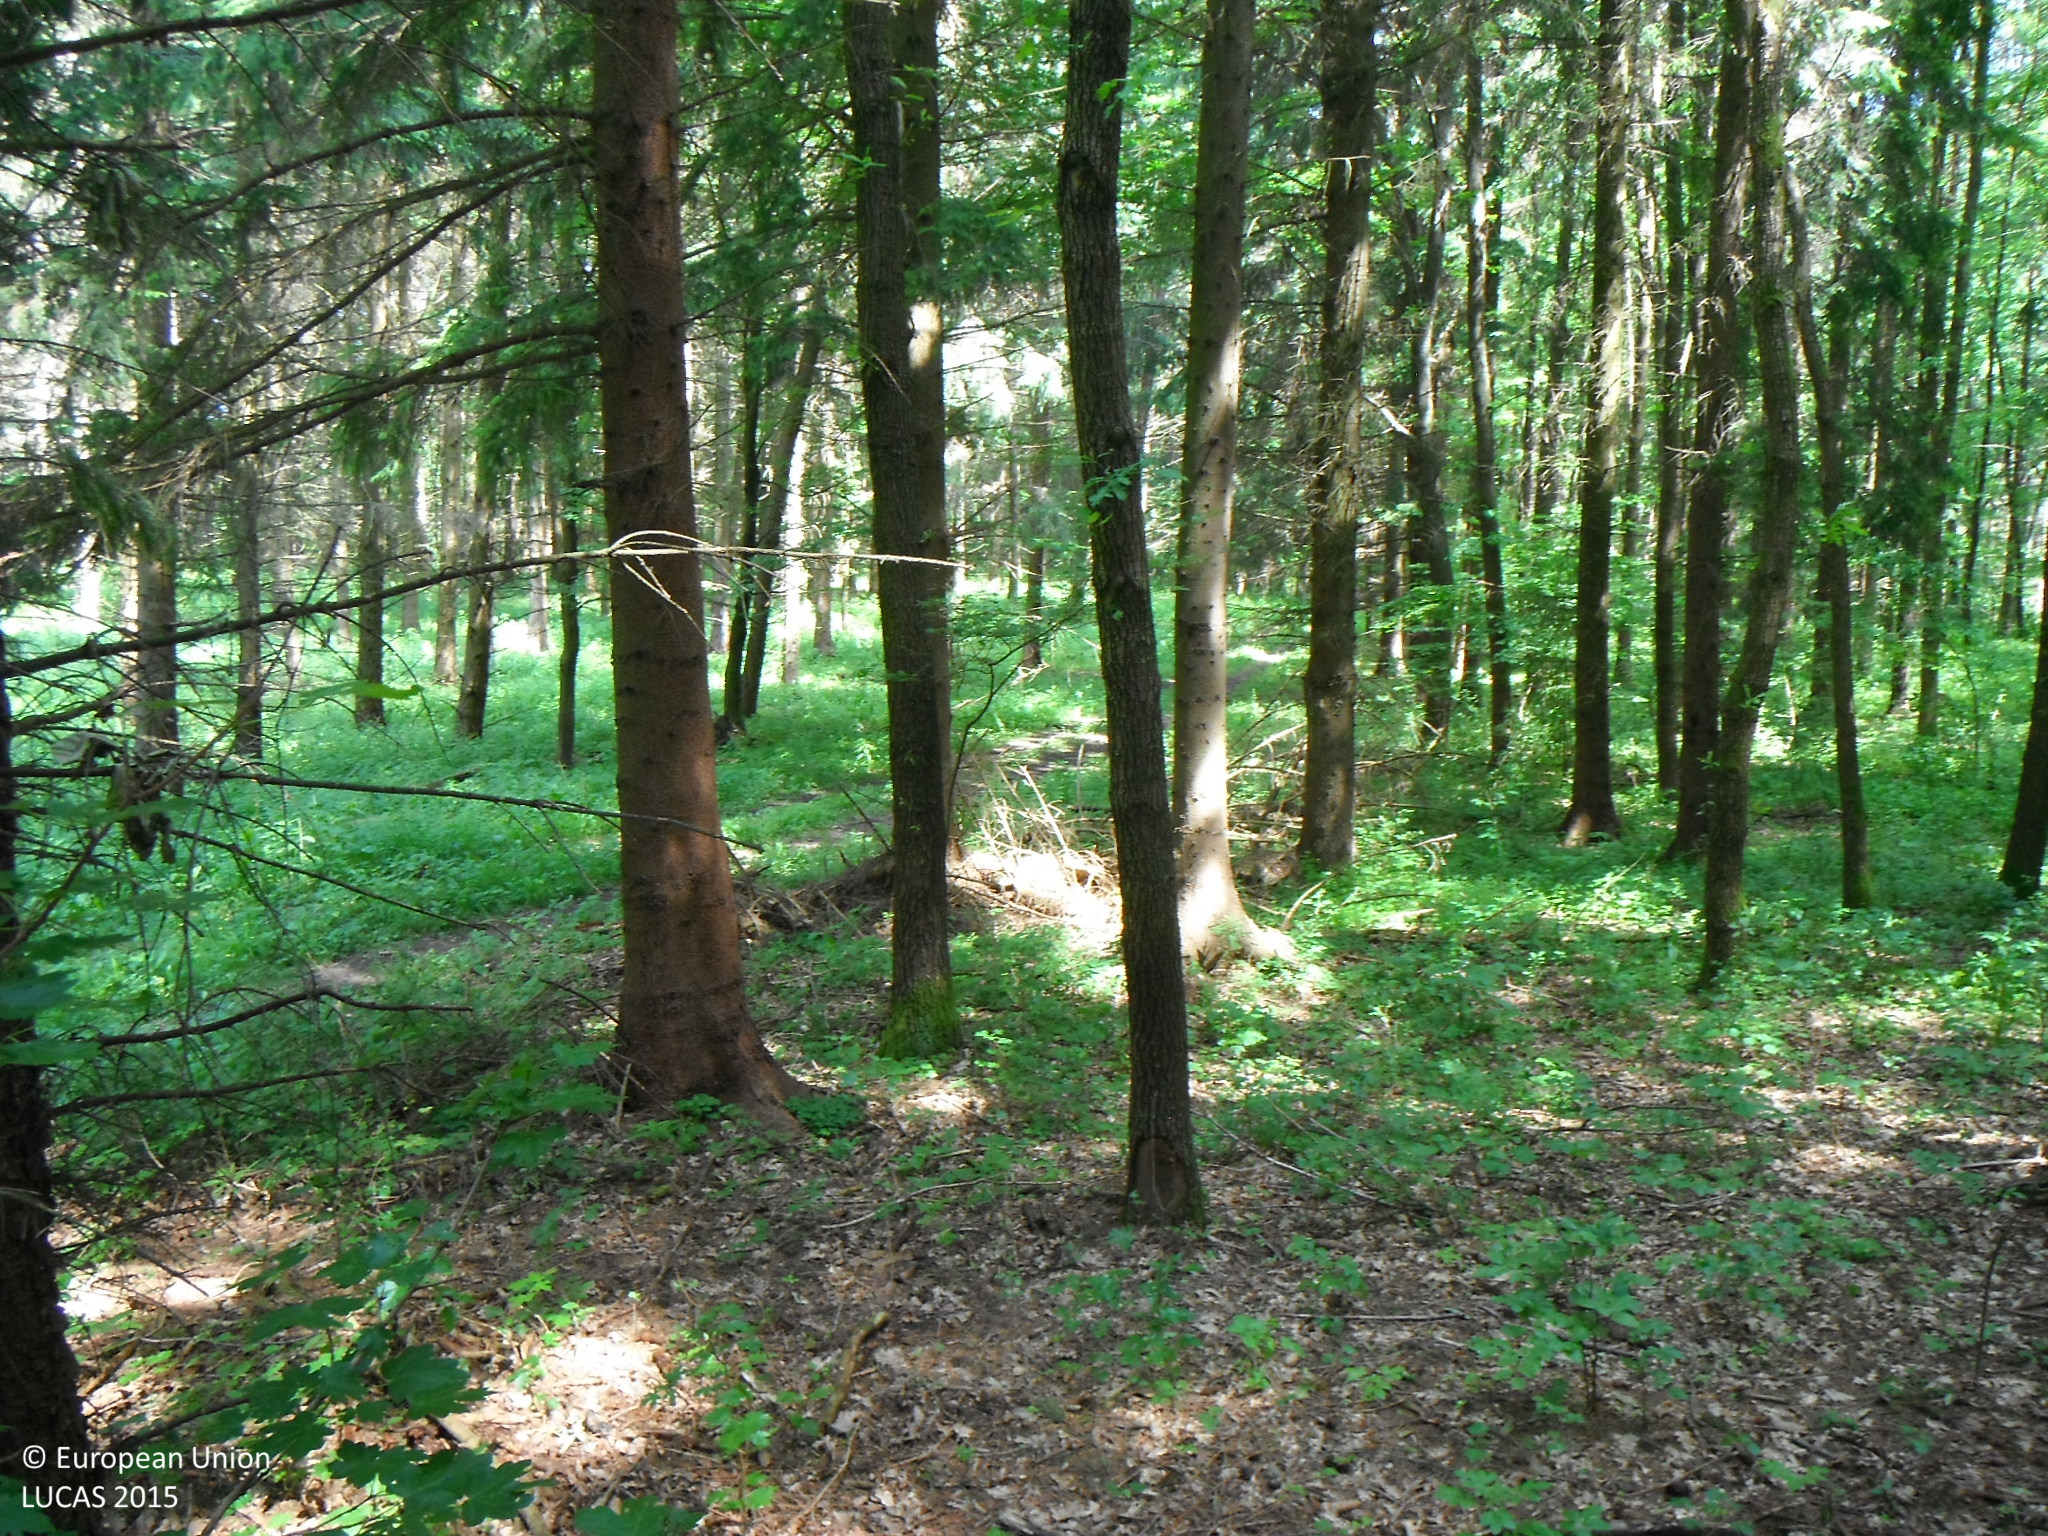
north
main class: Woodland
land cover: Spruce dominated coniferous woodland
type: hemiboreal forest and nemoral coniferous forest and mixed broadleaved-coniferous forest
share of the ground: > 75 %
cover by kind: coniferous forest trees 100 %
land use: Forestry
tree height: > 5 m
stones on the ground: < 10 %
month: June
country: SK
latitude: 48.7070
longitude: 18.7570
